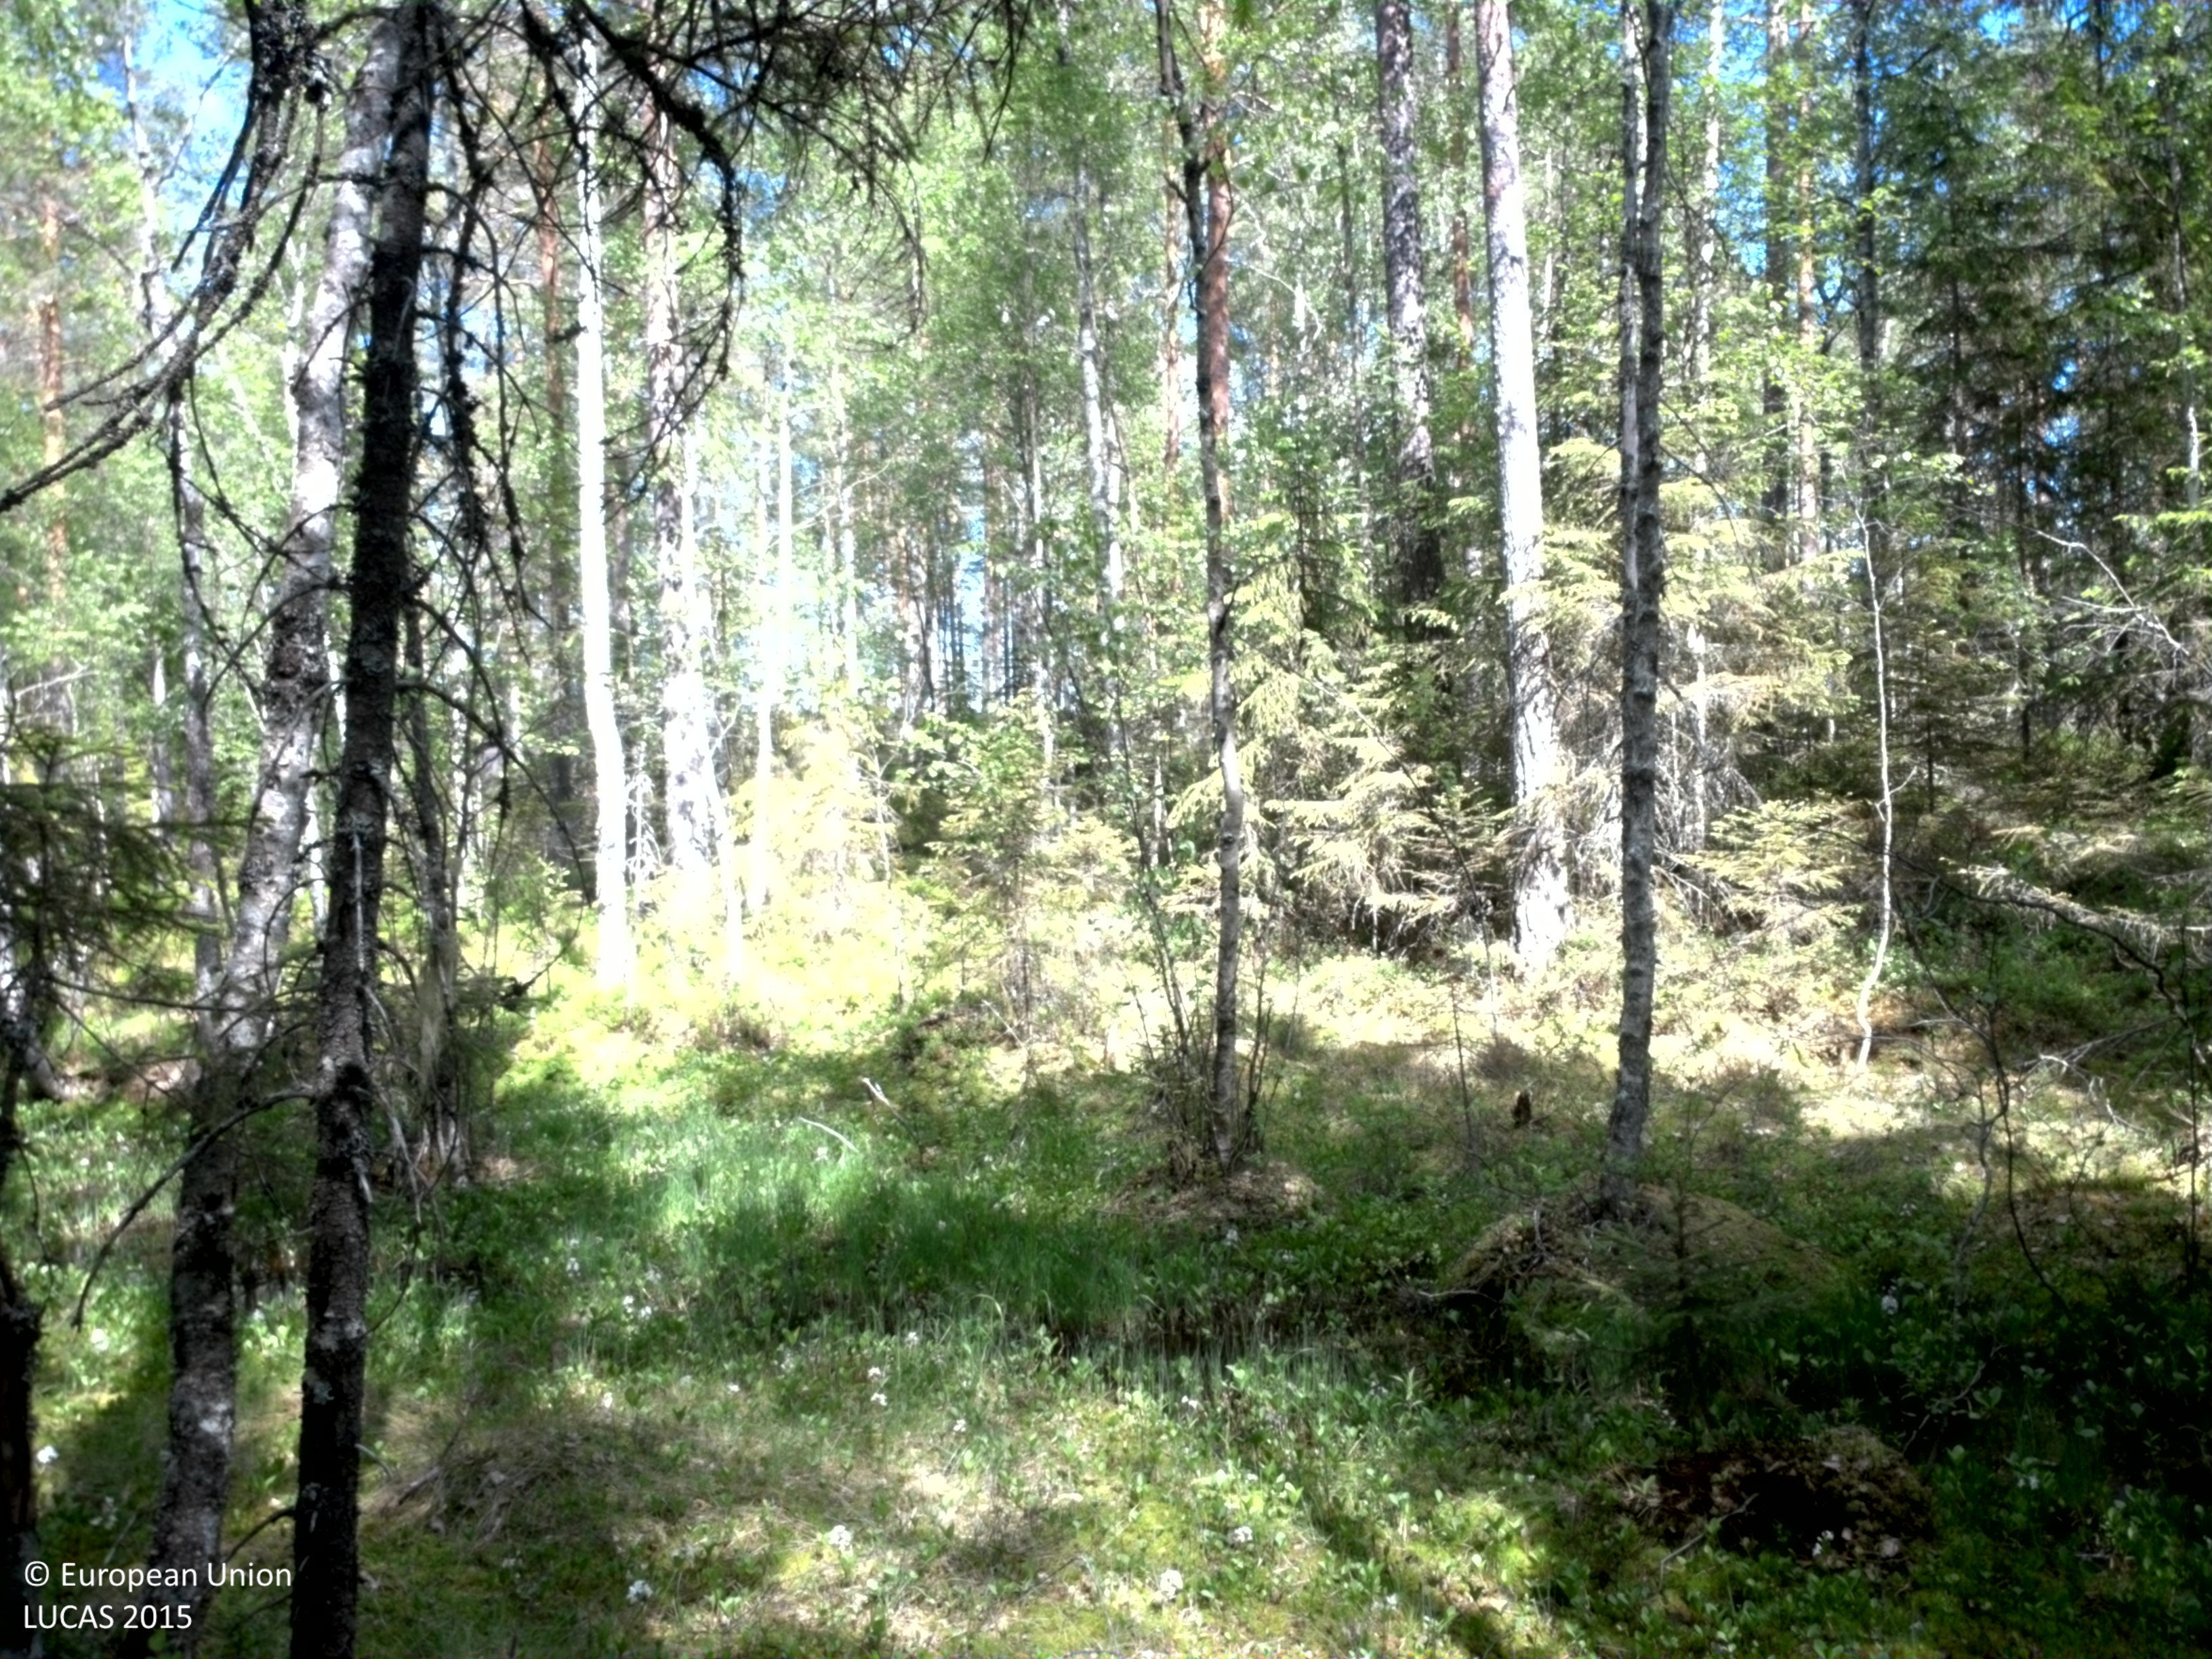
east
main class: Woodland
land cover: Pine dominated mixed woodland
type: boreal forest
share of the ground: 25 - 50 %
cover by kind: coniferous forest trees 35 %, lichens and mosses 25 %, shrubs 20 %, broadleaved forest trees 15 %, herbaceous plants 5 %
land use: Forestry
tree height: > 5 m
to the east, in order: Pine dominated mixed woodland; Rivers and streams; Pine dominated coniferous woodland; Inland fresh water bodies
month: June
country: SE
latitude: 59.6258
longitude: 12.0335
